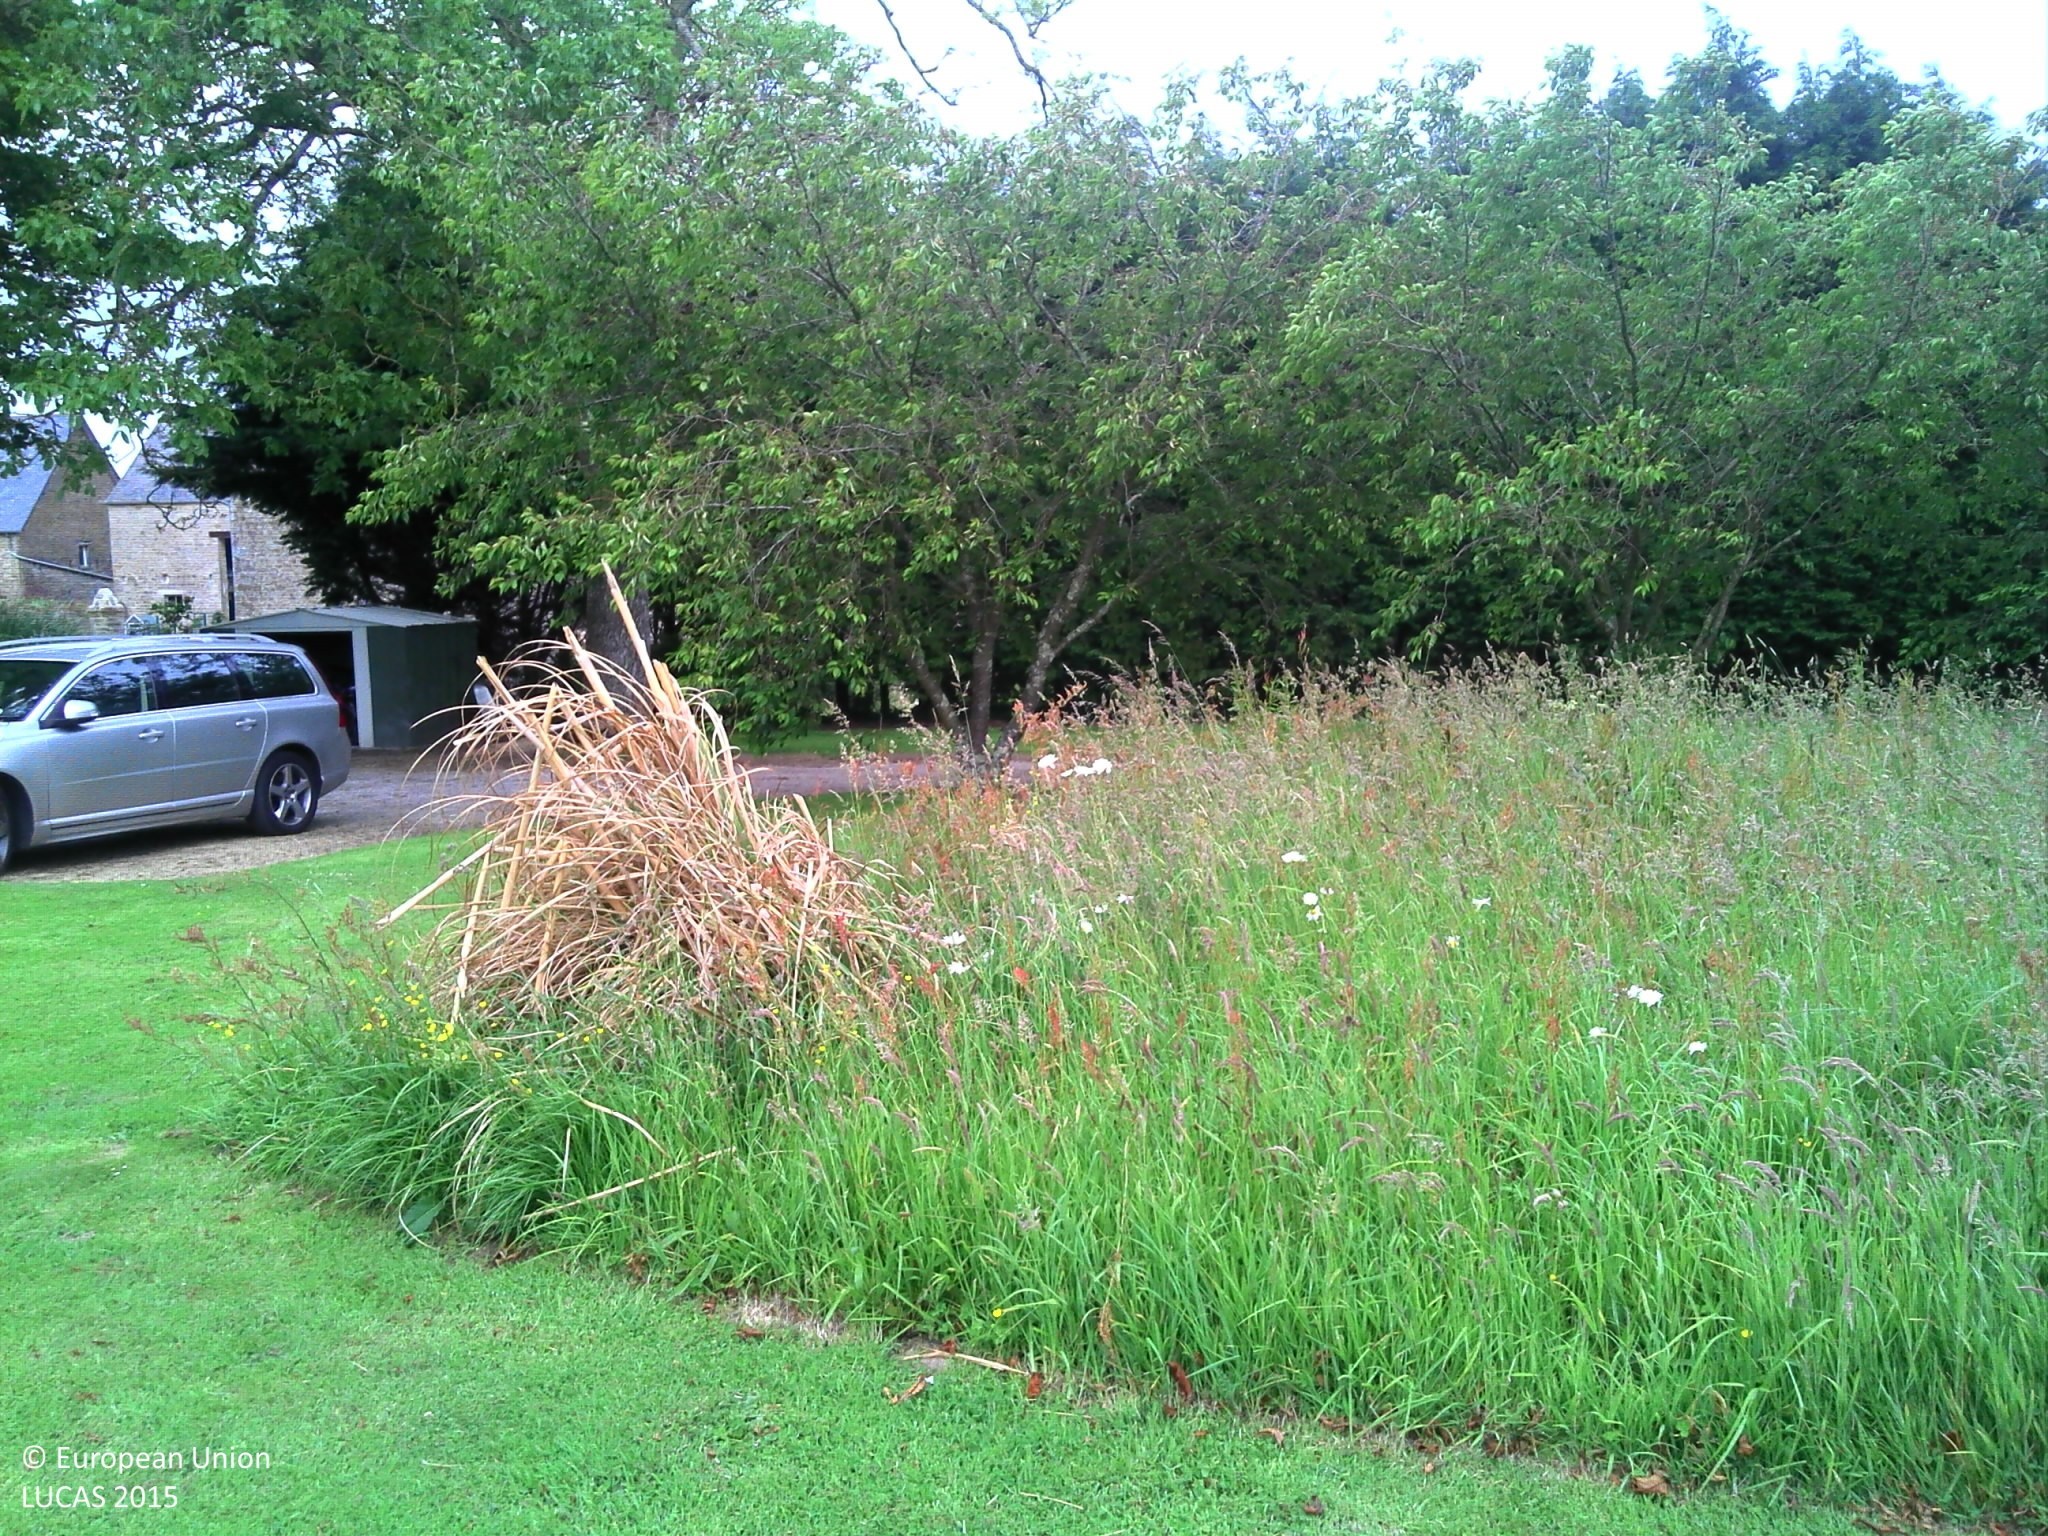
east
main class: Grassland
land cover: Grassland without tree/shrub cover
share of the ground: > 75 %
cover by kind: herbaceous plants 100 %
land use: Residential
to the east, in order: Grassland without tree/shrub cover; Artificial constructions in urban areas; Dry stone walls; Grass margins; Paved roads, cycling and walking lanes; Grass margins; Electric lines; Spontaneously vegetated surfaces; Common wheat
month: June
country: FR
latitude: 49.3759
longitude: -1.3829
